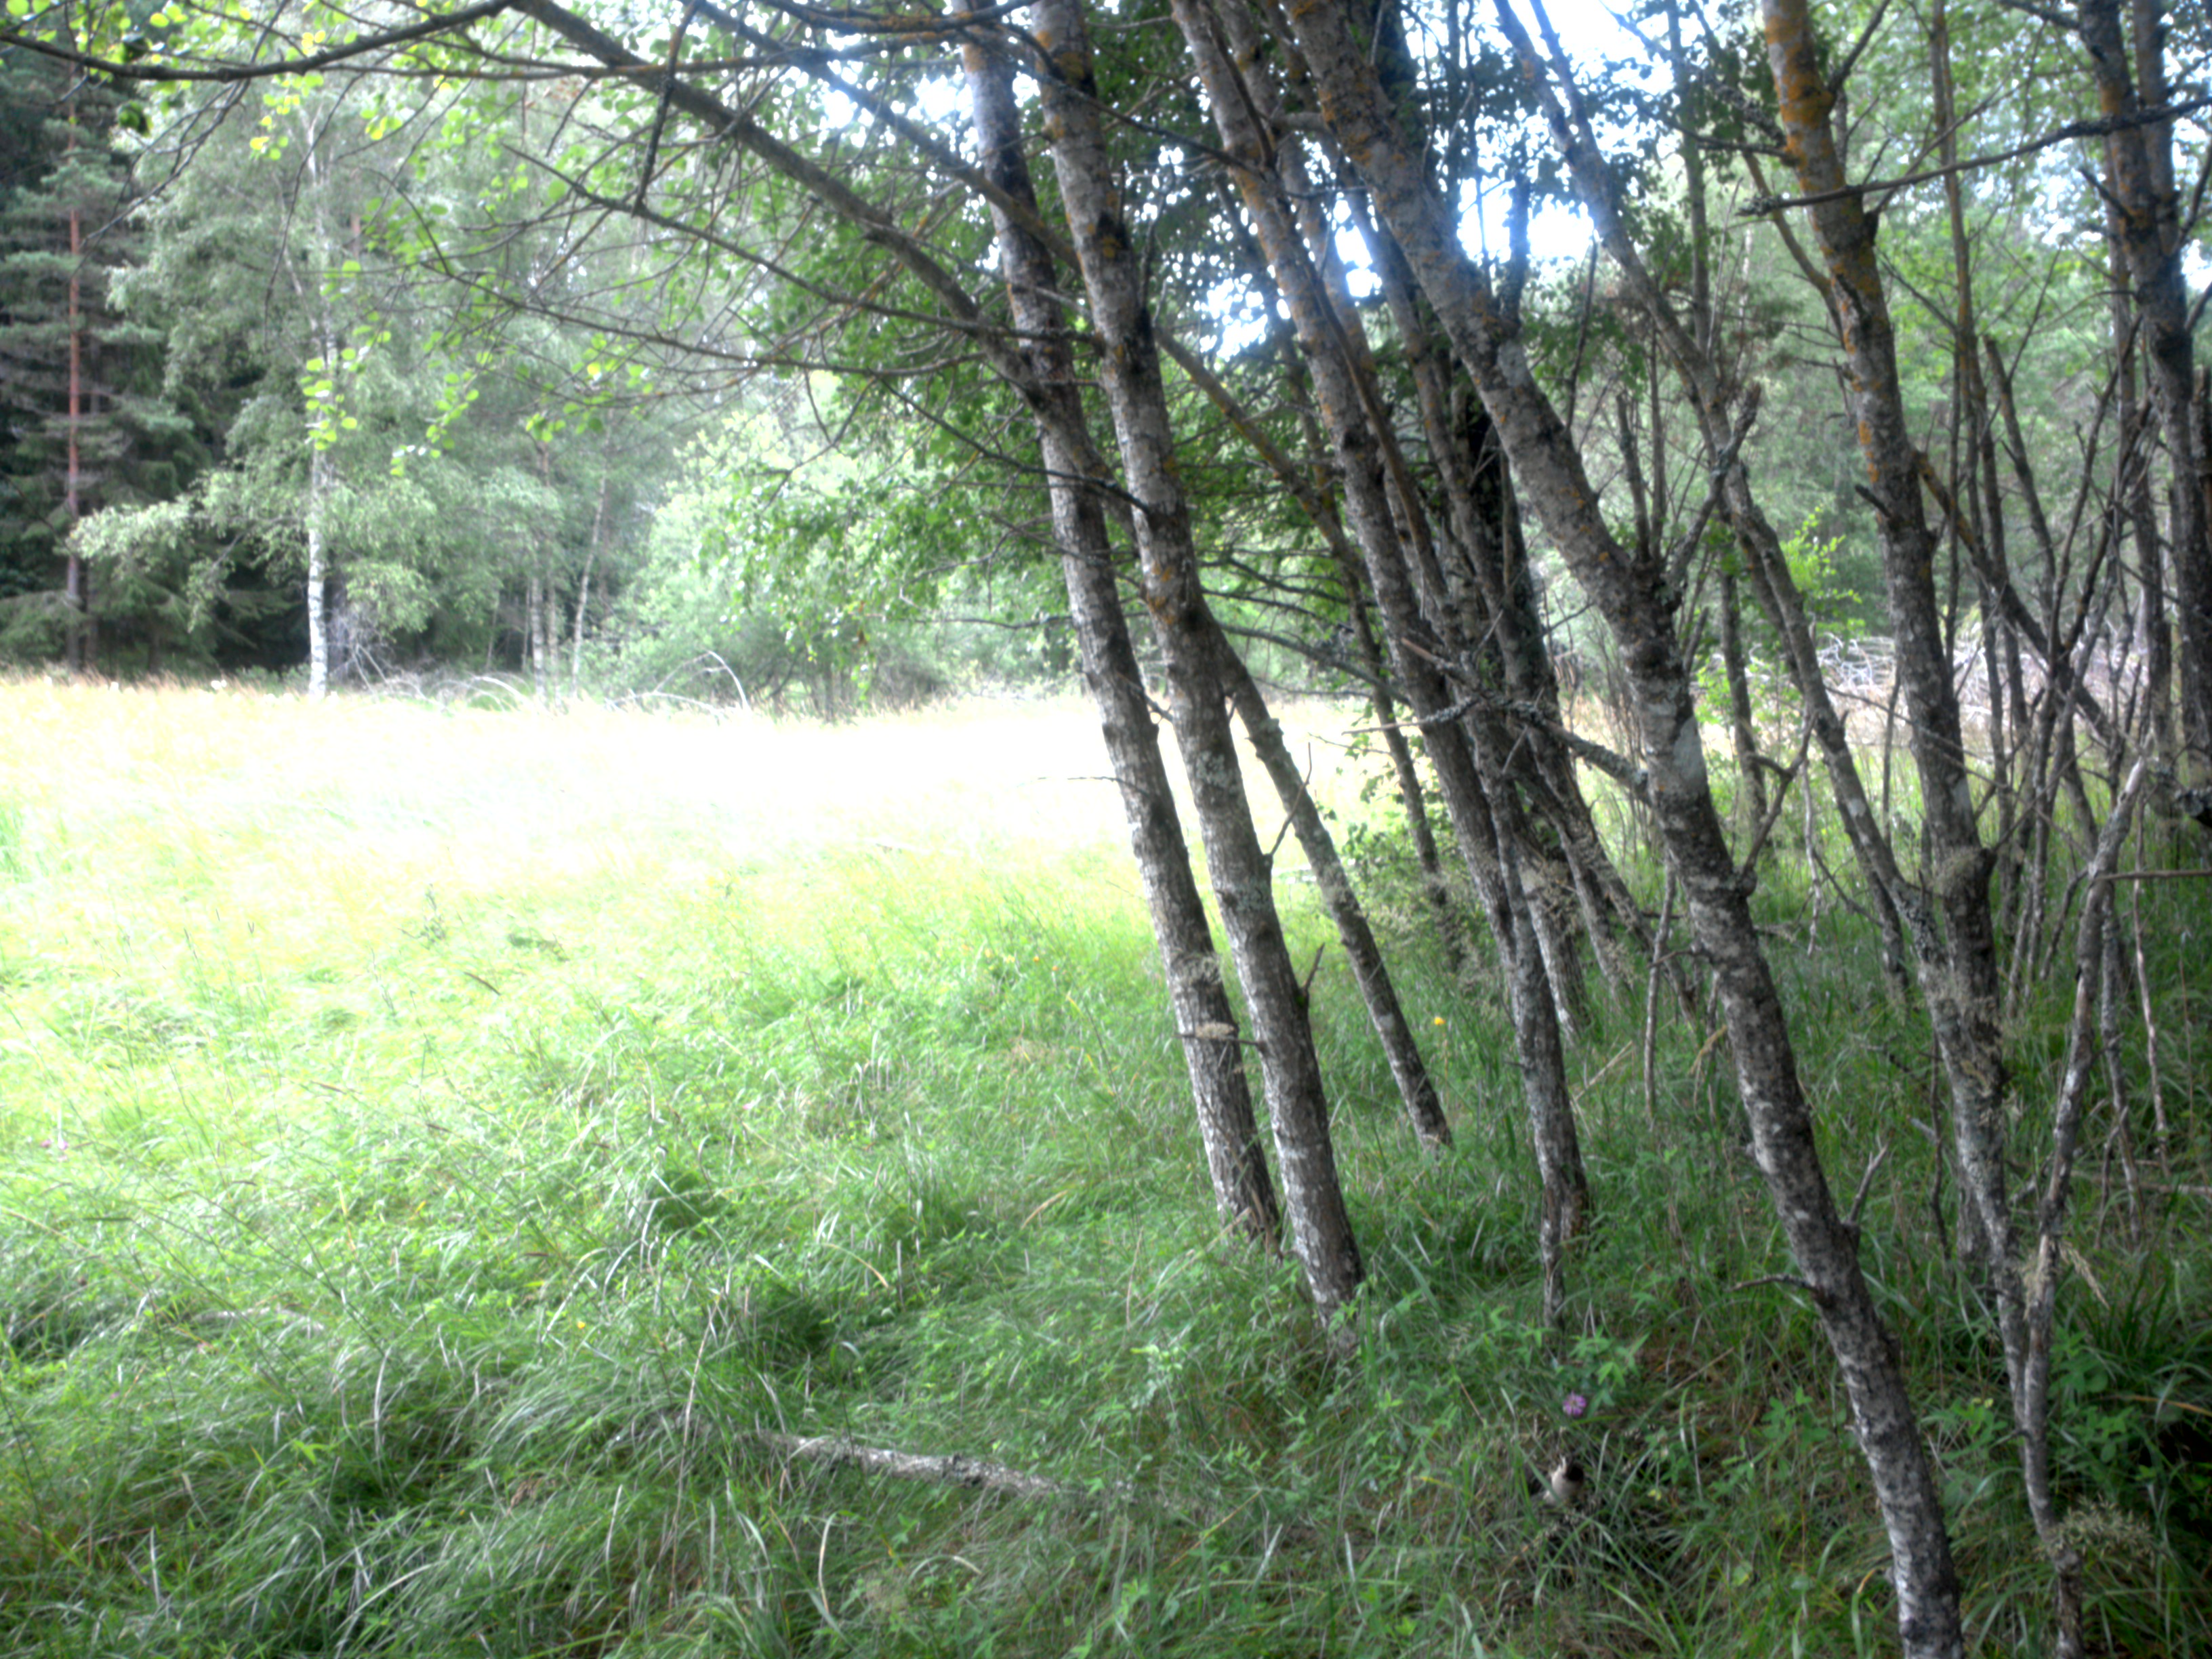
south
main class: Woodland
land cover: Broadleaved woodland
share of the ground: > 75 %
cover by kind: broadleaved forest trees 90 %, herbaceous plants 5 %, lichens and mosses 5 %
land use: Amenities, museums, leisure
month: July
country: SE
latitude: 59.2124
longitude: 18.2851
